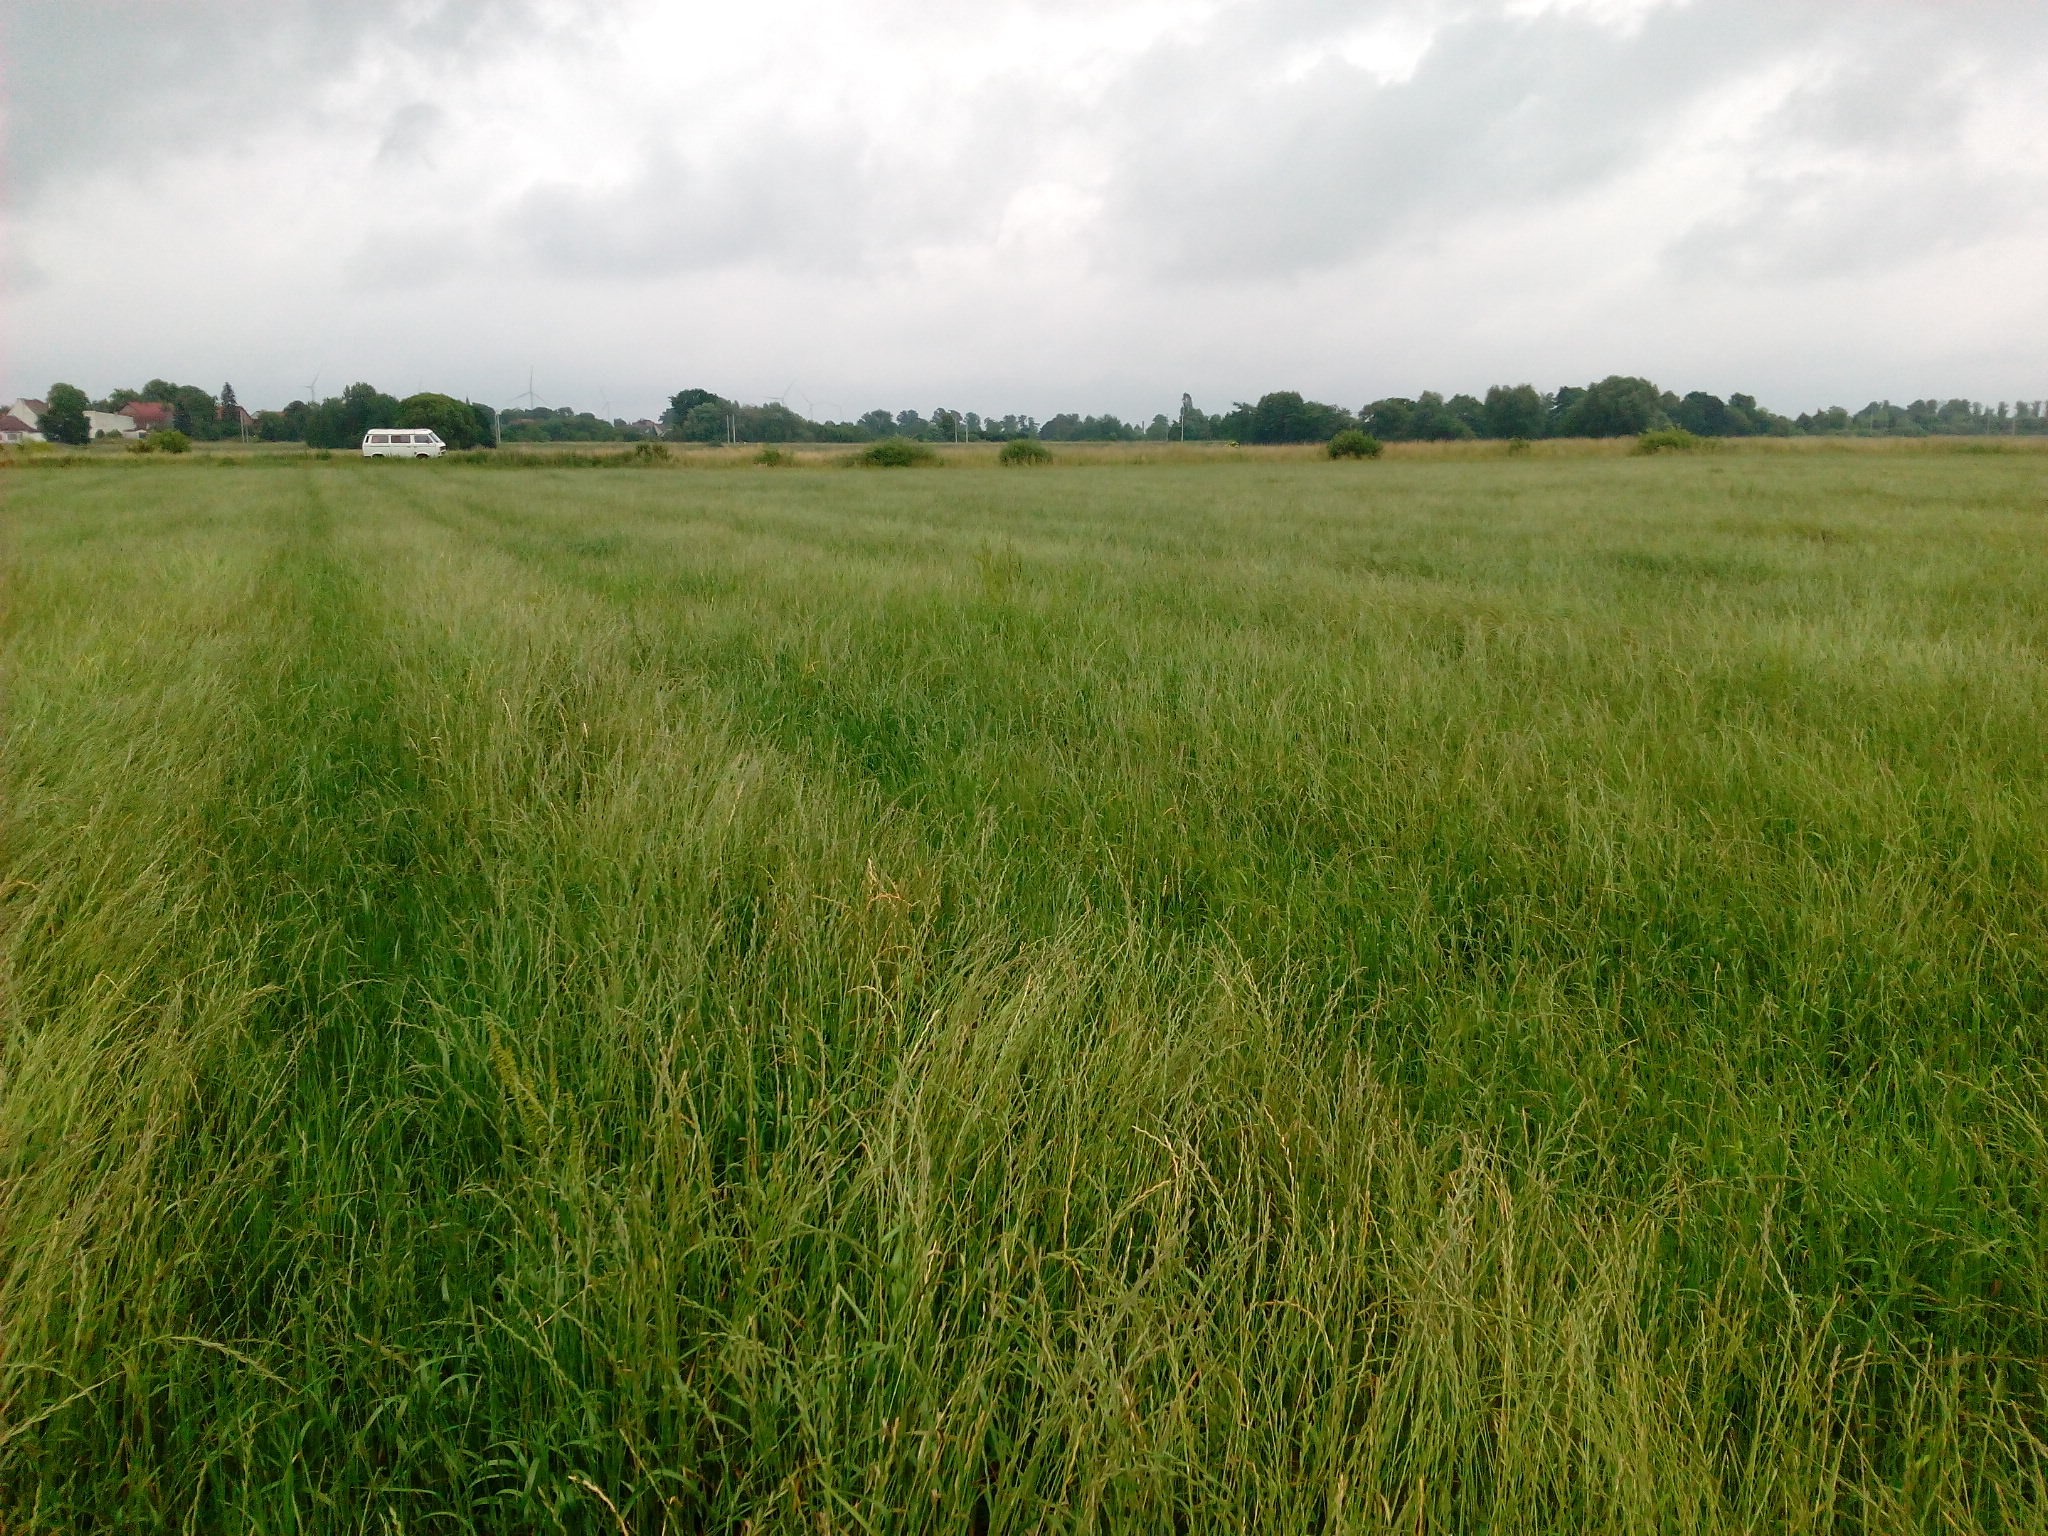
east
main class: Cropland
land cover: Temporary grasslands
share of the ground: > 75 %
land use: Agriculture (excluding fallow land and kitchen gardens)
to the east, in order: Temporary grasslands; Shrubland with sparse tree cover; Ditches and canals; Grassland without tree/shrub cover; Tracks; Grassland without tree/shrub cover; Ditches and canals; Grassland without tree/shrub cover
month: June
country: DE
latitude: 53.0365
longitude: 13.1763
